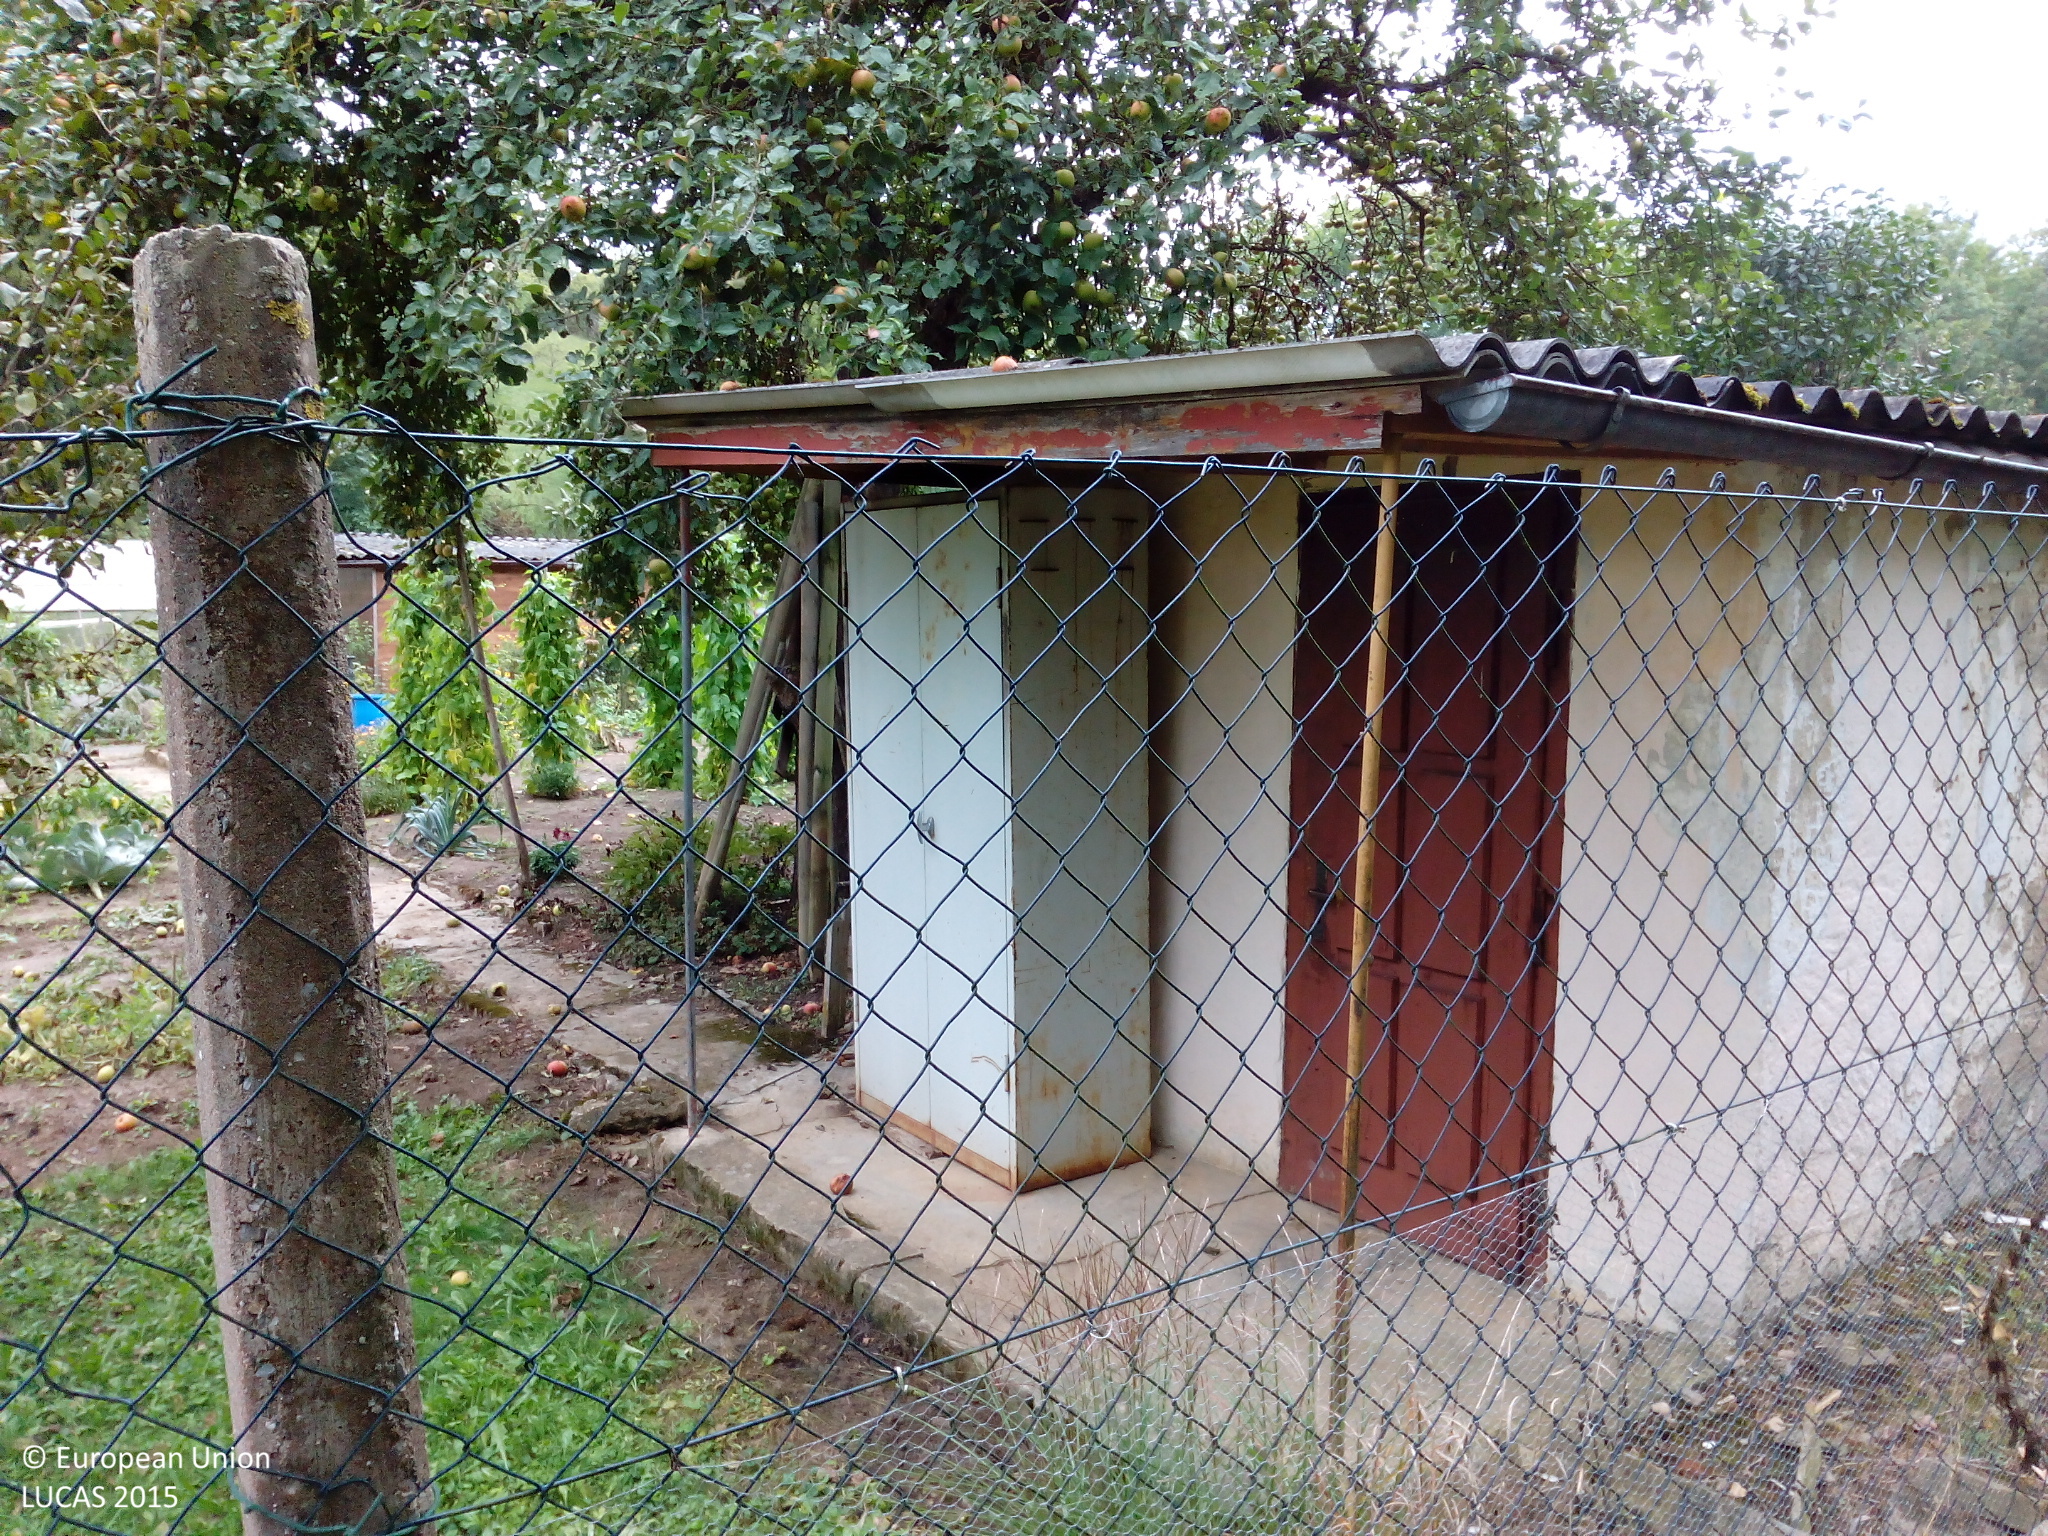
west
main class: Cropland
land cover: Apple fruit
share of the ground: > 75 %
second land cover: Grassland without tree/shrub cover
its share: > 75 %
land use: Kitchen garden
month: September
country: DE
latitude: 49.8425
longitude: 9.9583
